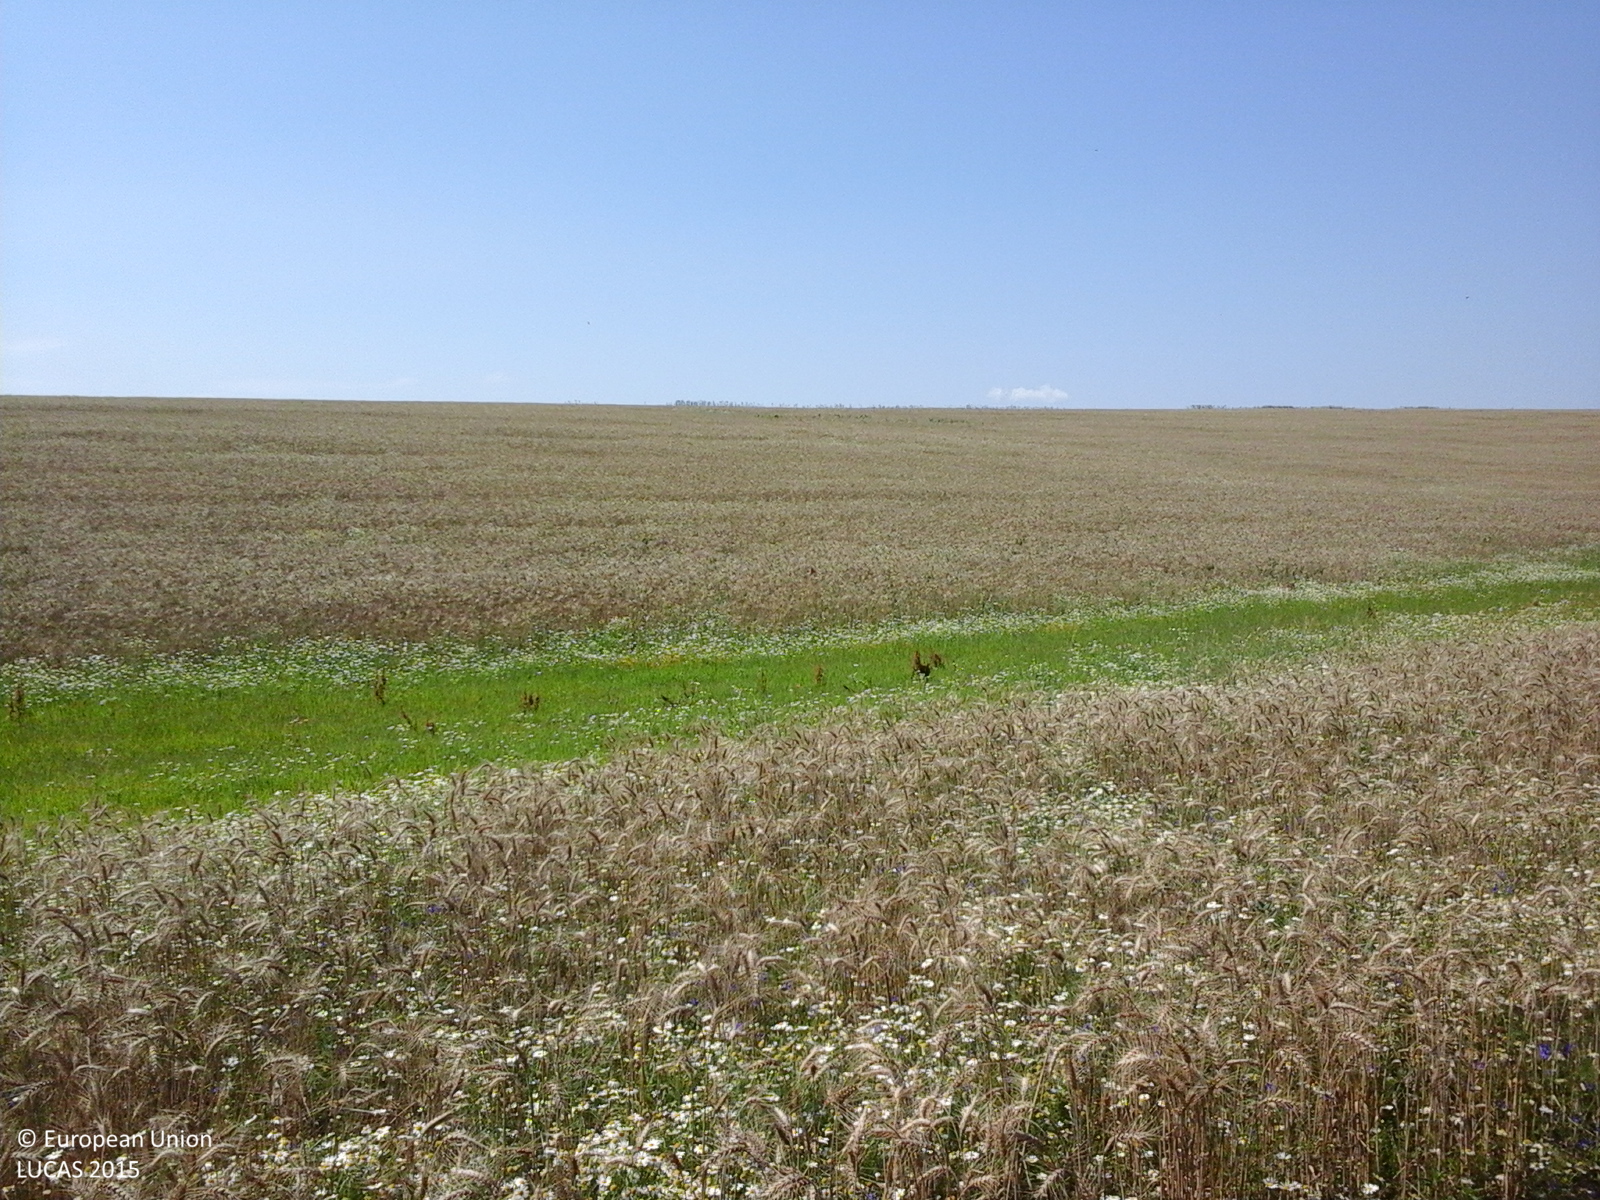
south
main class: Cropland
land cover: Common wheat
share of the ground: > 75 %
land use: Agriculture (excluding fallow land and kitchen gardens)
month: July
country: RO
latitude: 44.1730
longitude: 24.8459
